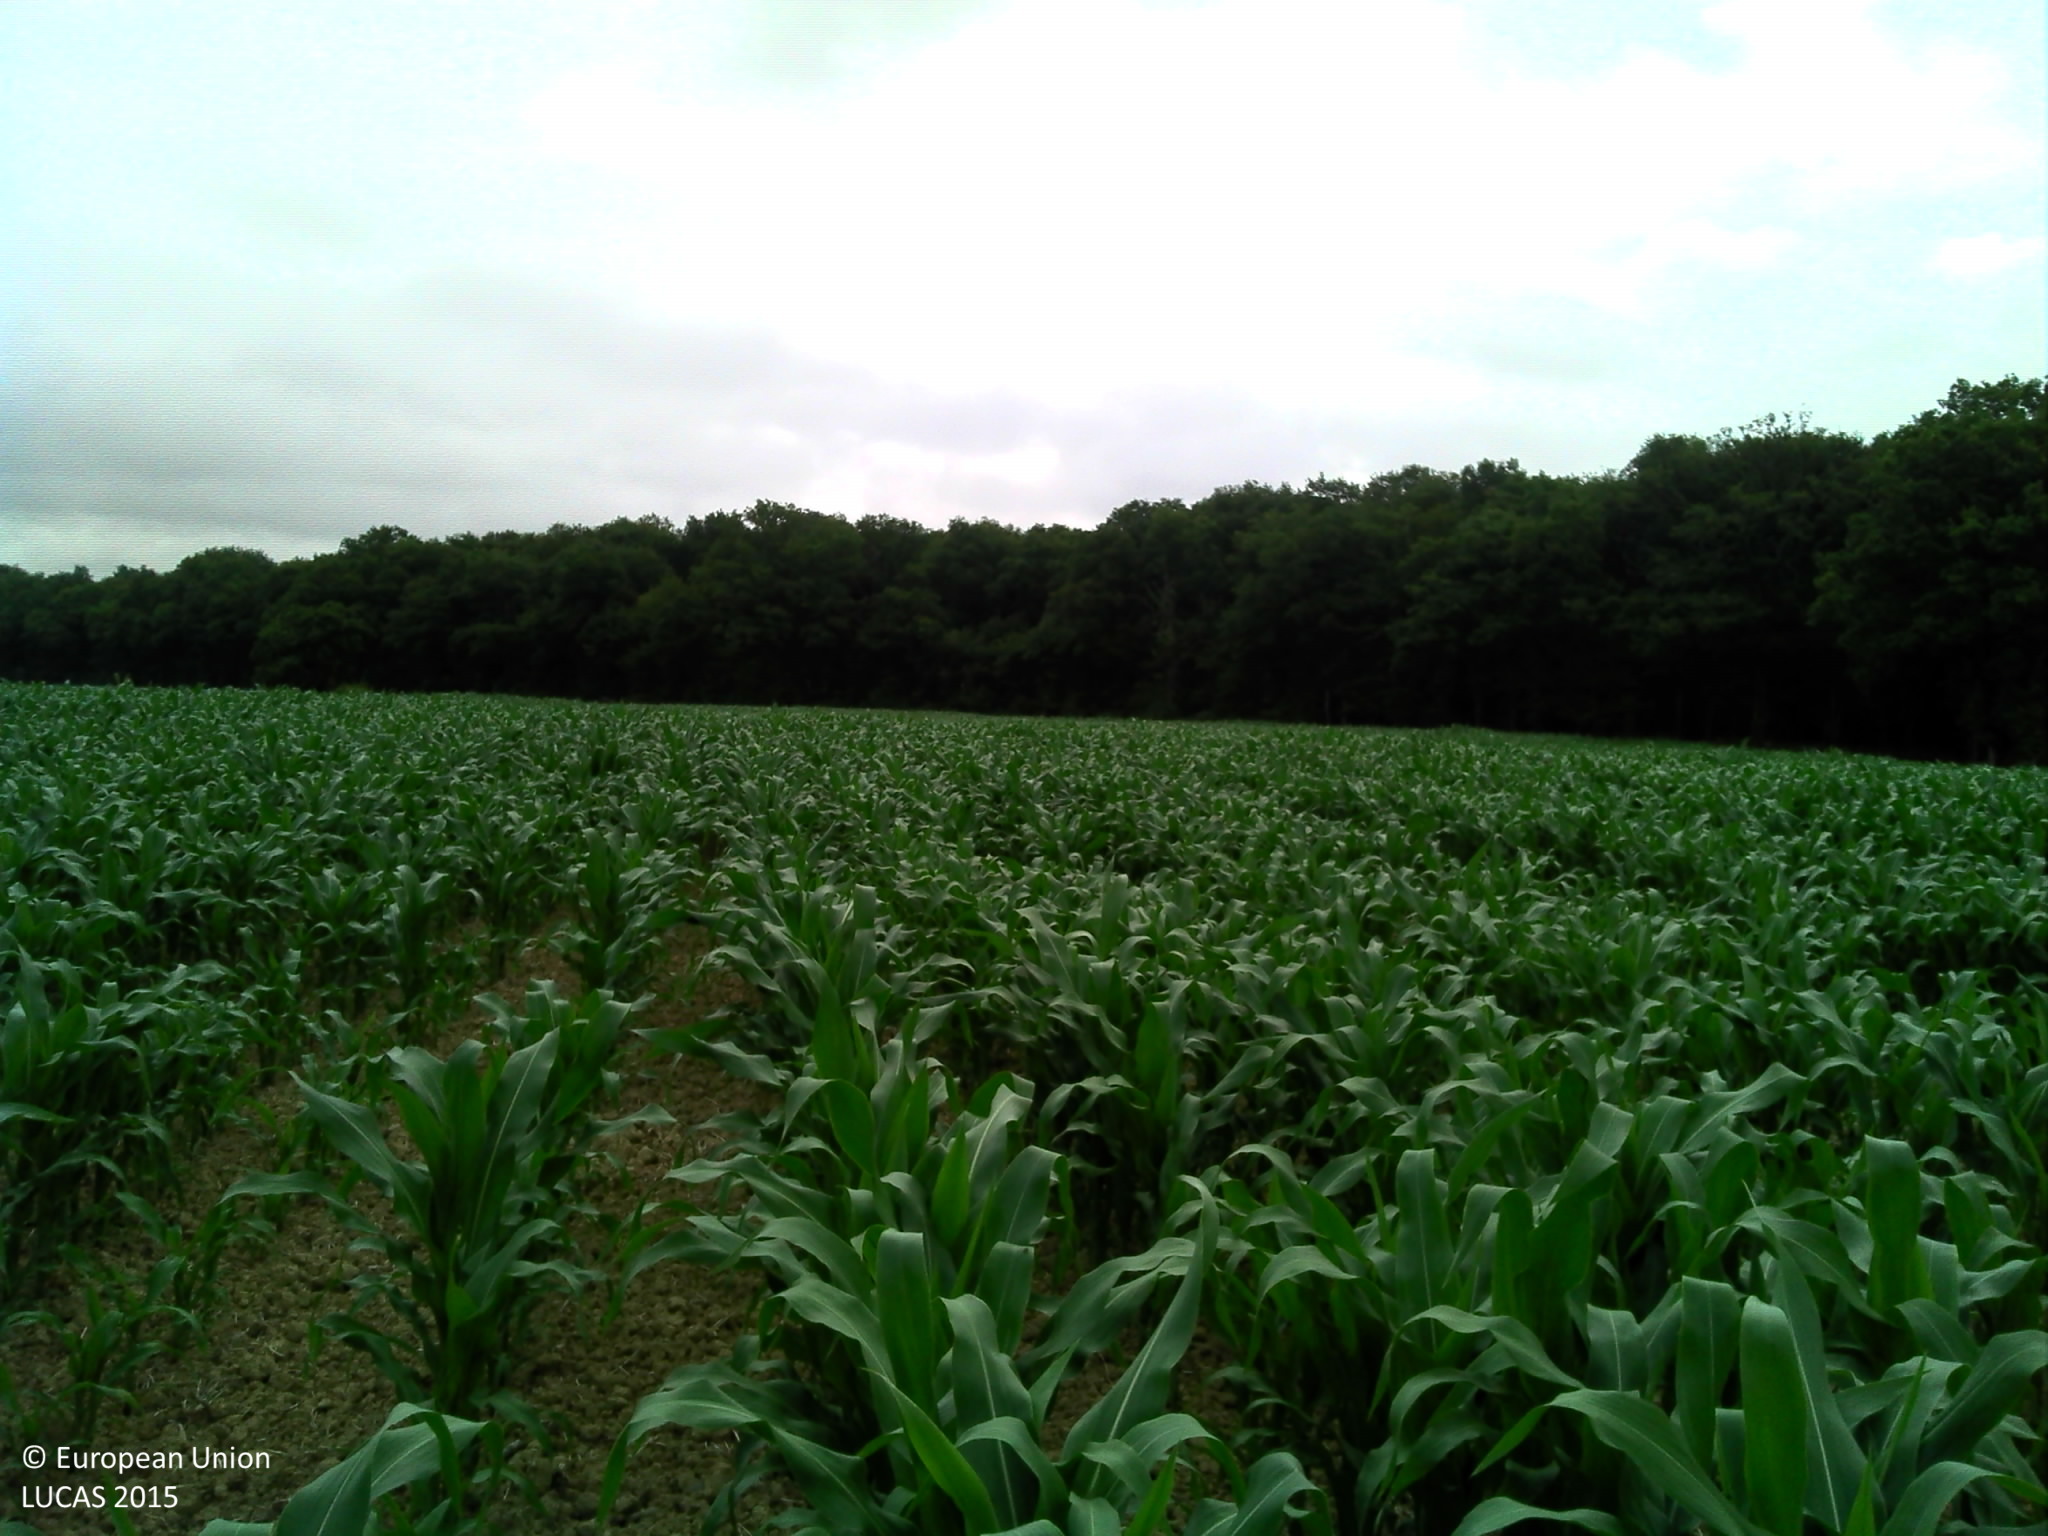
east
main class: Cropland
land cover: Maize
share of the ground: 25 - 50 %
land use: Agriculture (excluding fallow land and kitchen gardens)
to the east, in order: Maize; Grass margins; Fences; Broadleaved woodland; Tracks; Broadleaved woodland
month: July
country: FR
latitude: 47.8465
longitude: -1.4153
